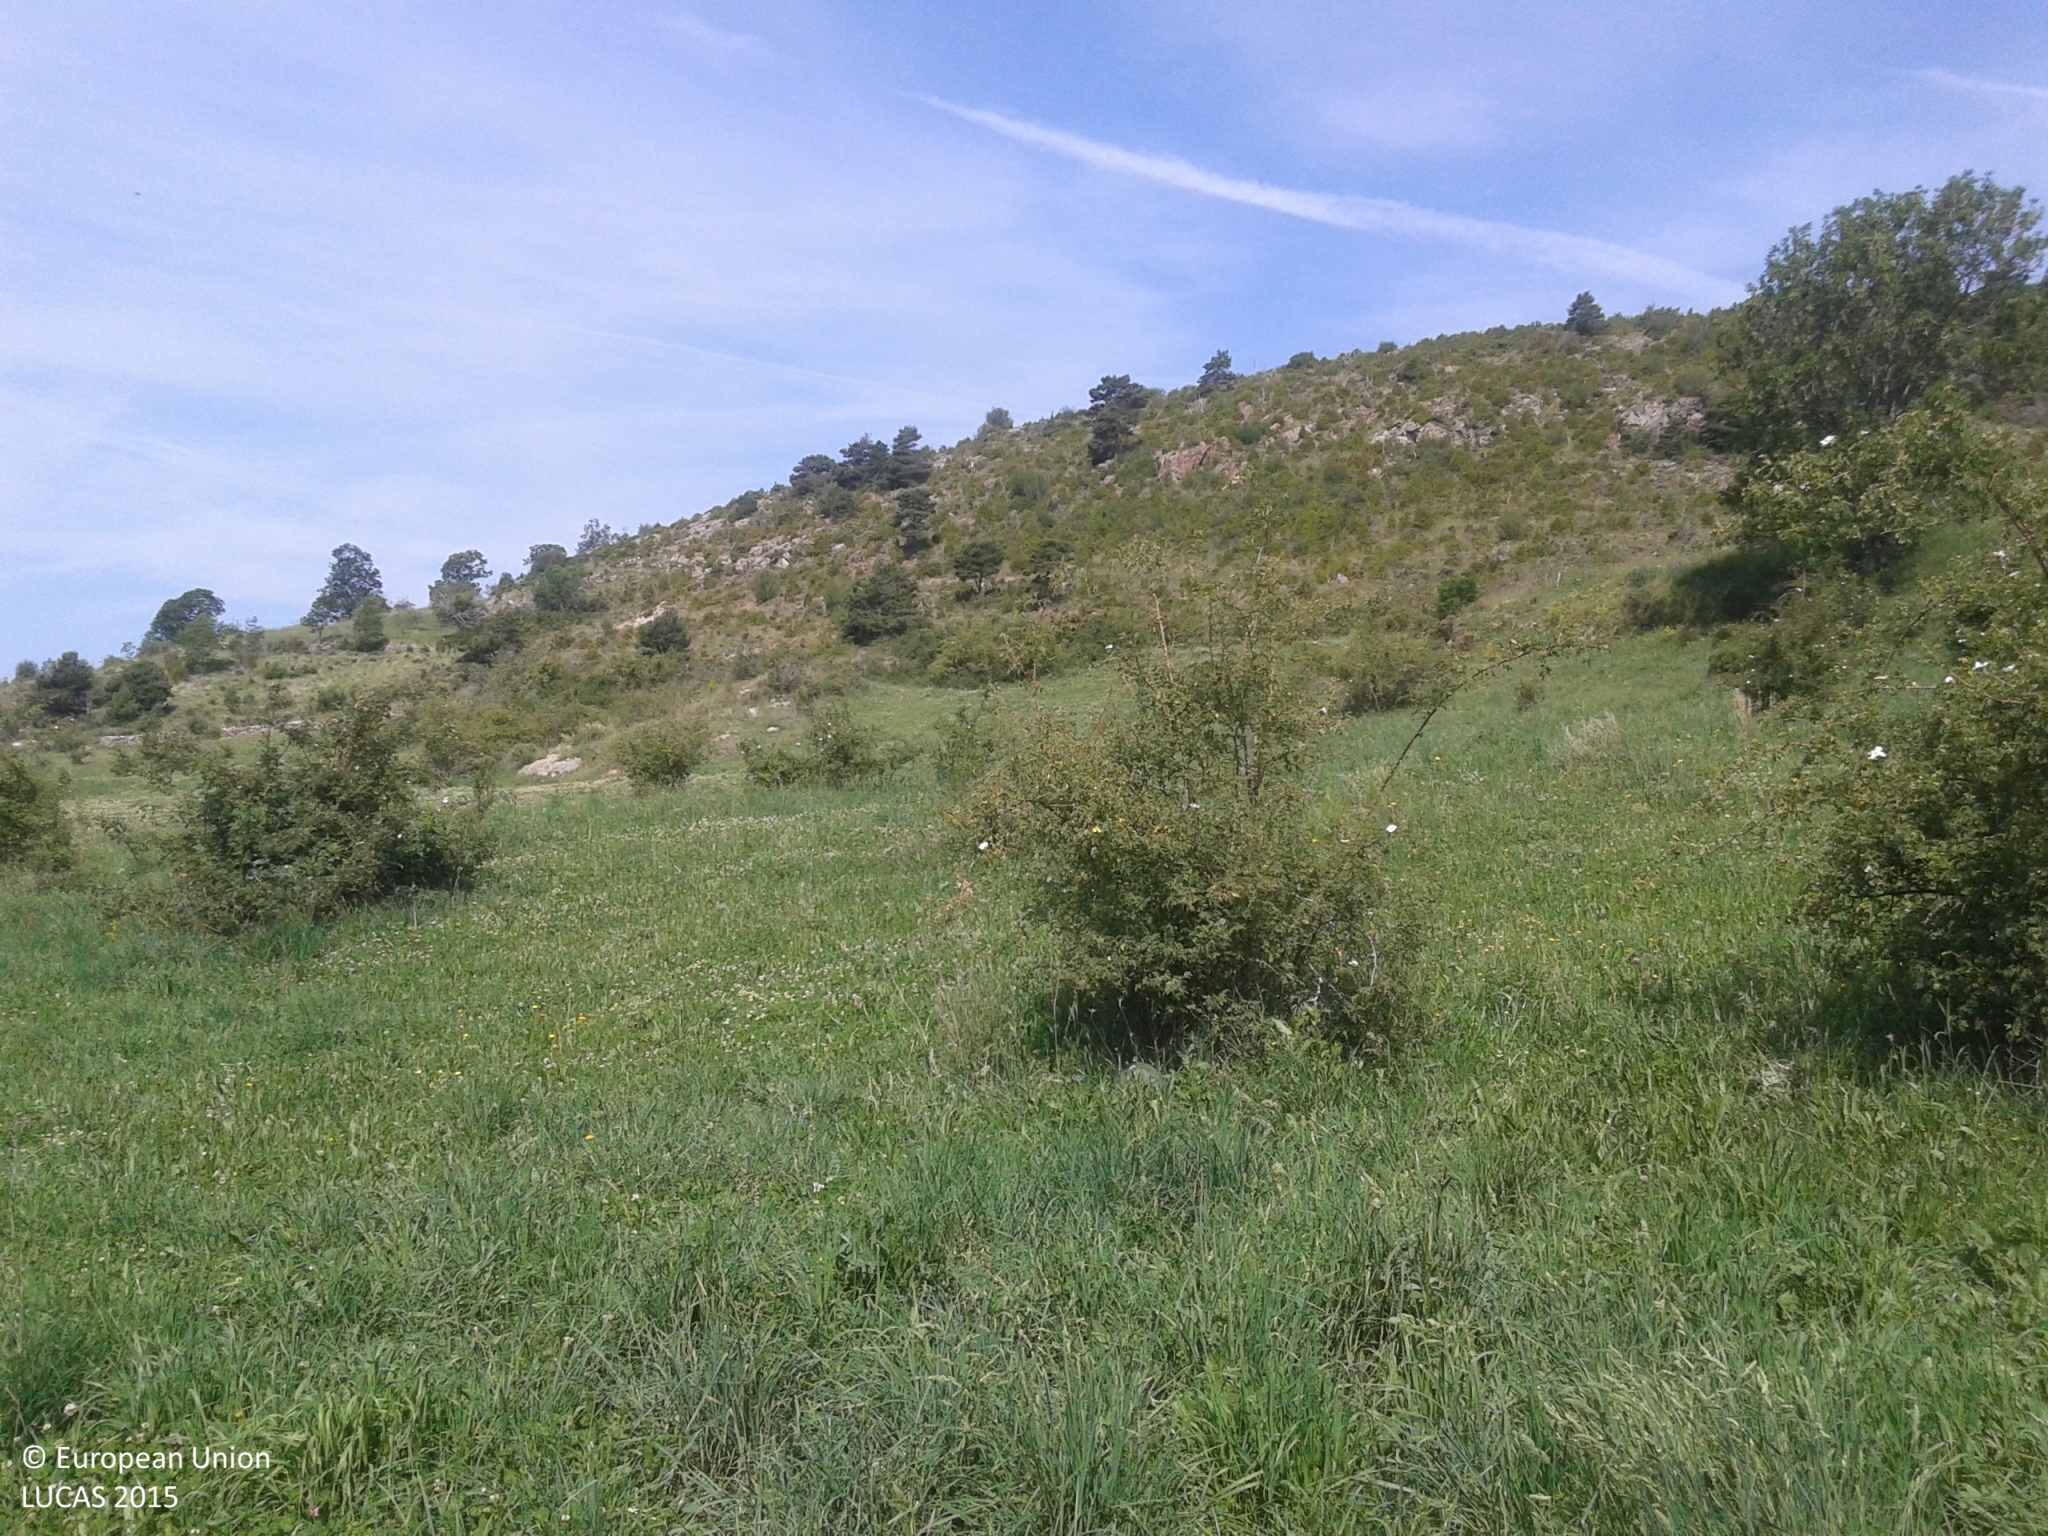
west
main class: Grassland
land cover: Grassland with sparse tree/shrub cover
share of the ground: > 75 %
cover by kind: herbaceous plants 90 %, broadleaved forest trees 5 %, shrubs 5 %
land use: Agriculture (excluding fallow land and kitchen gardens)
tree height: < 5 m
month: June
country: ES
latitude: 42.3926
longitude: 1.5675
